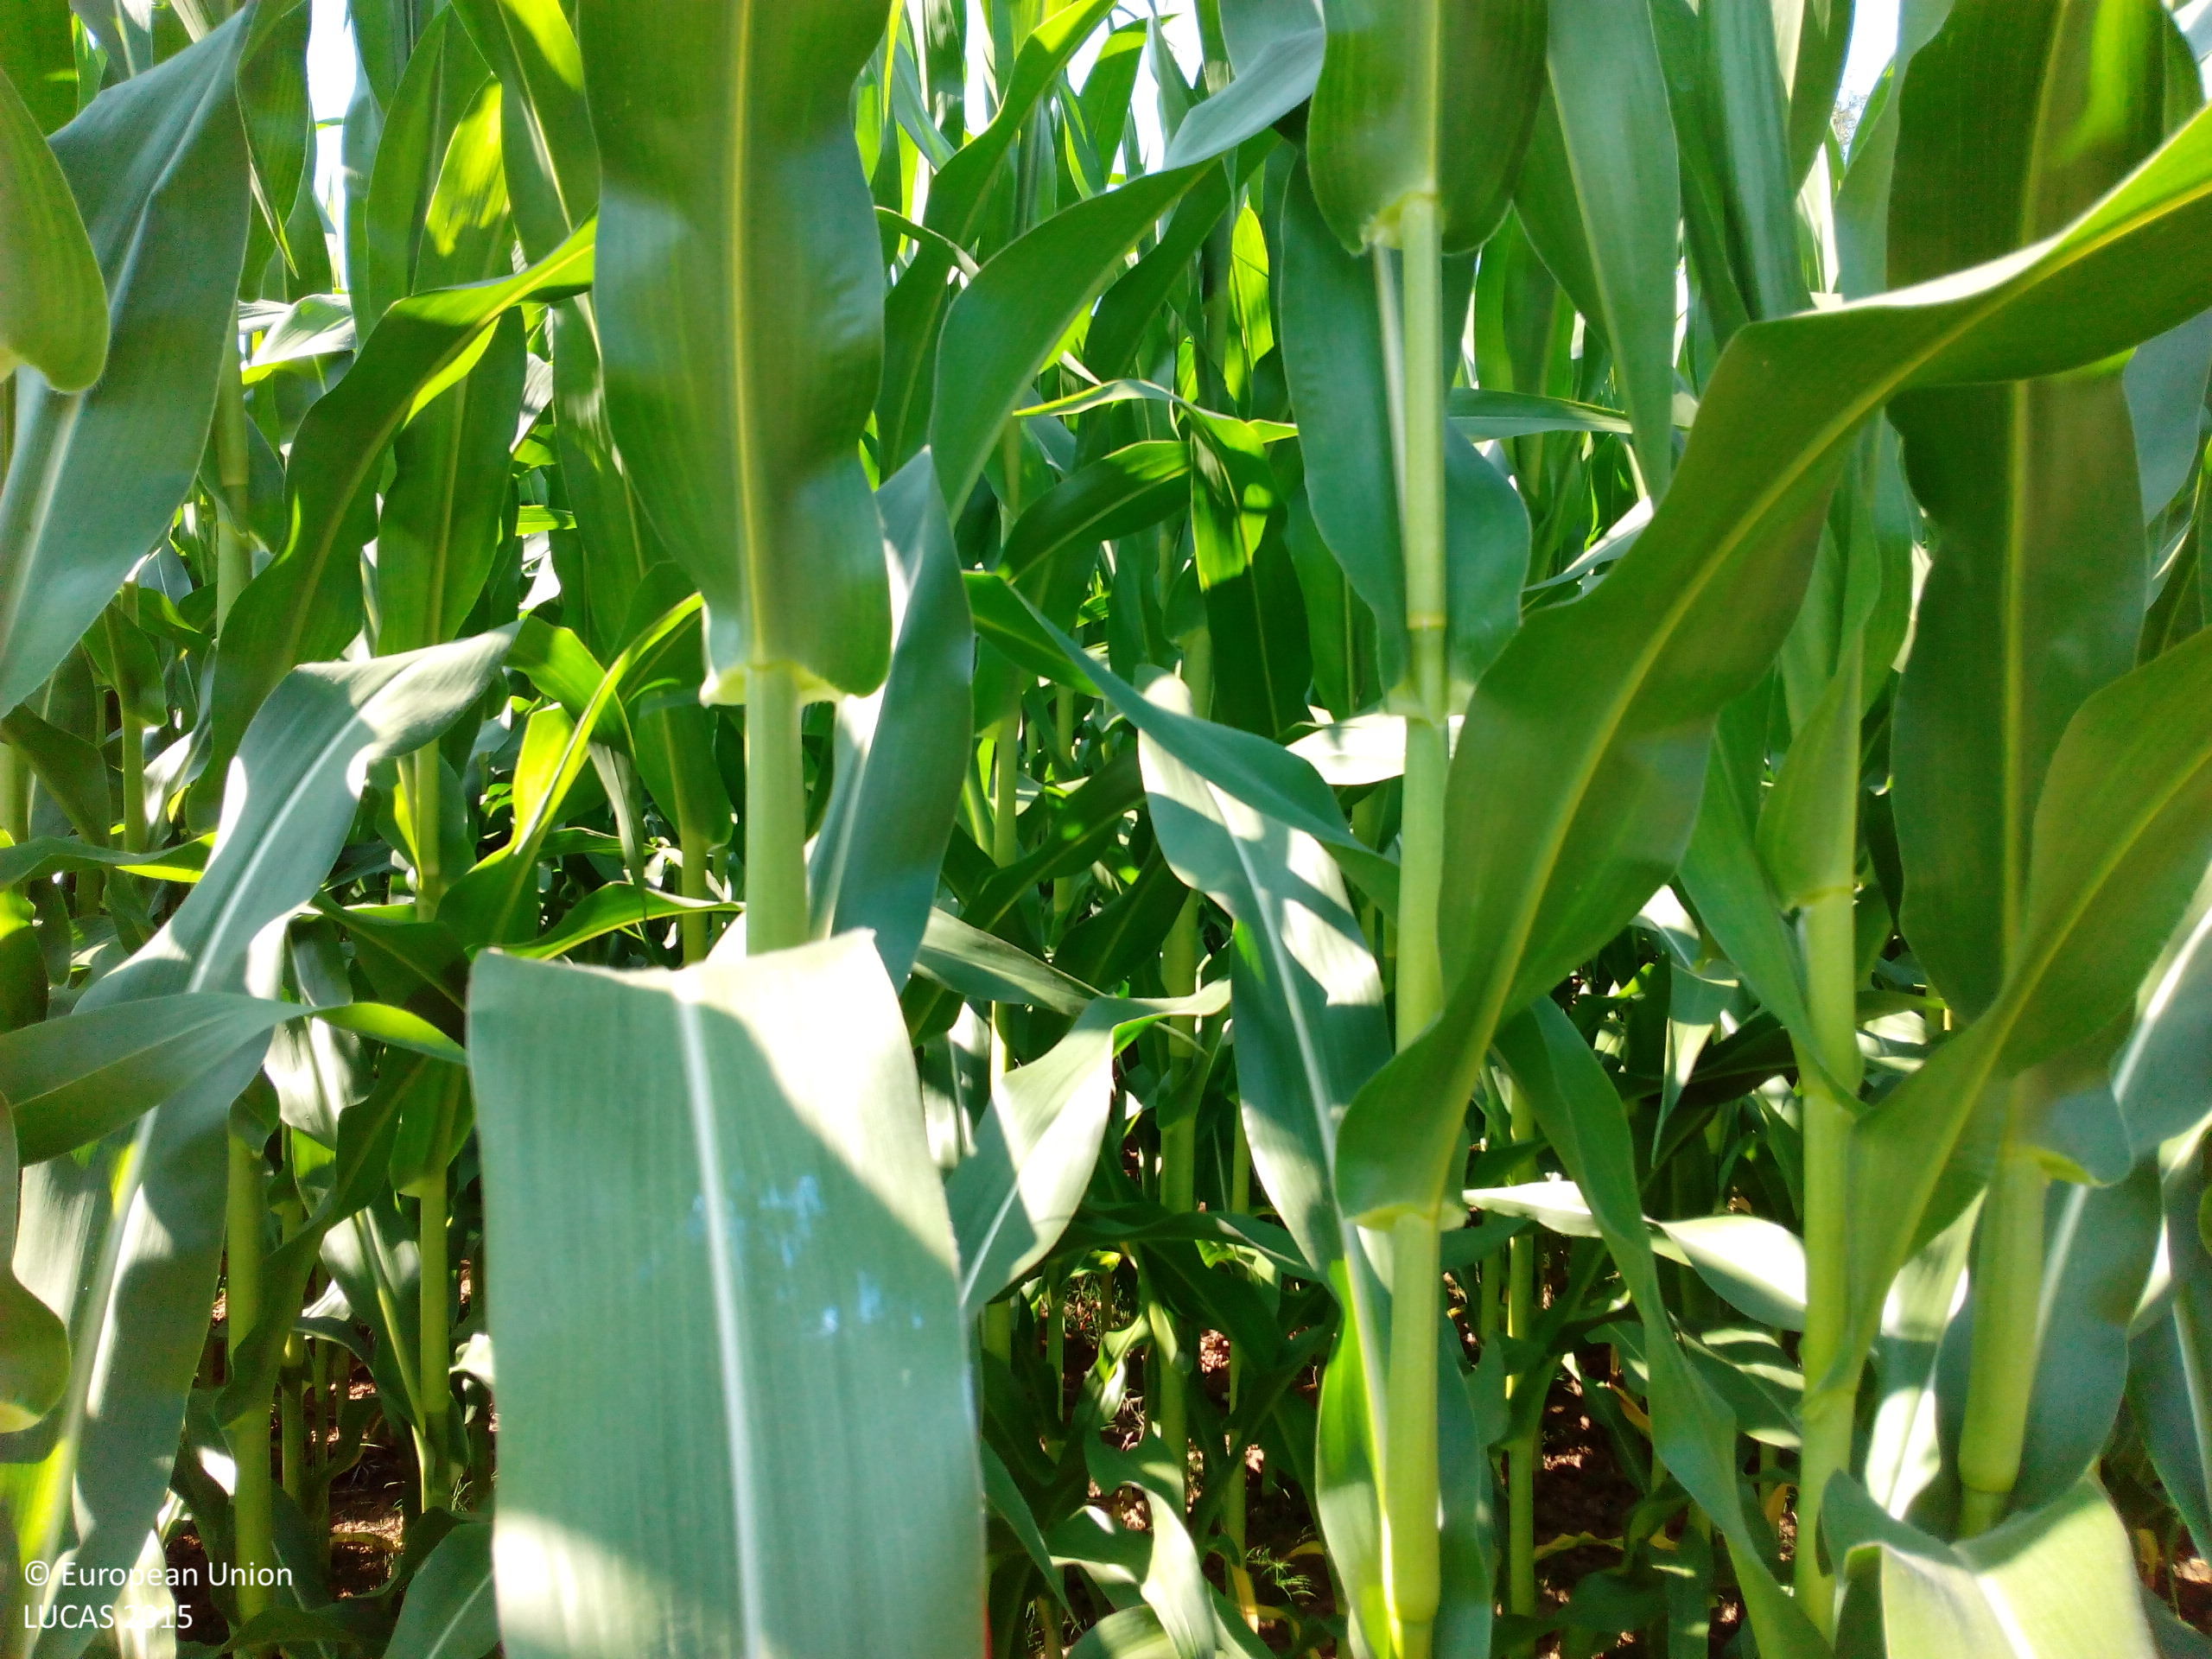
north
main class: Cropland
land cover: Maize
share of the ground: > 75 %
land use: Agriculture (excluding fallow land and kitchen gardens)
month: July
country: DE
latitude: 47.6763
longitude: 7.6439
